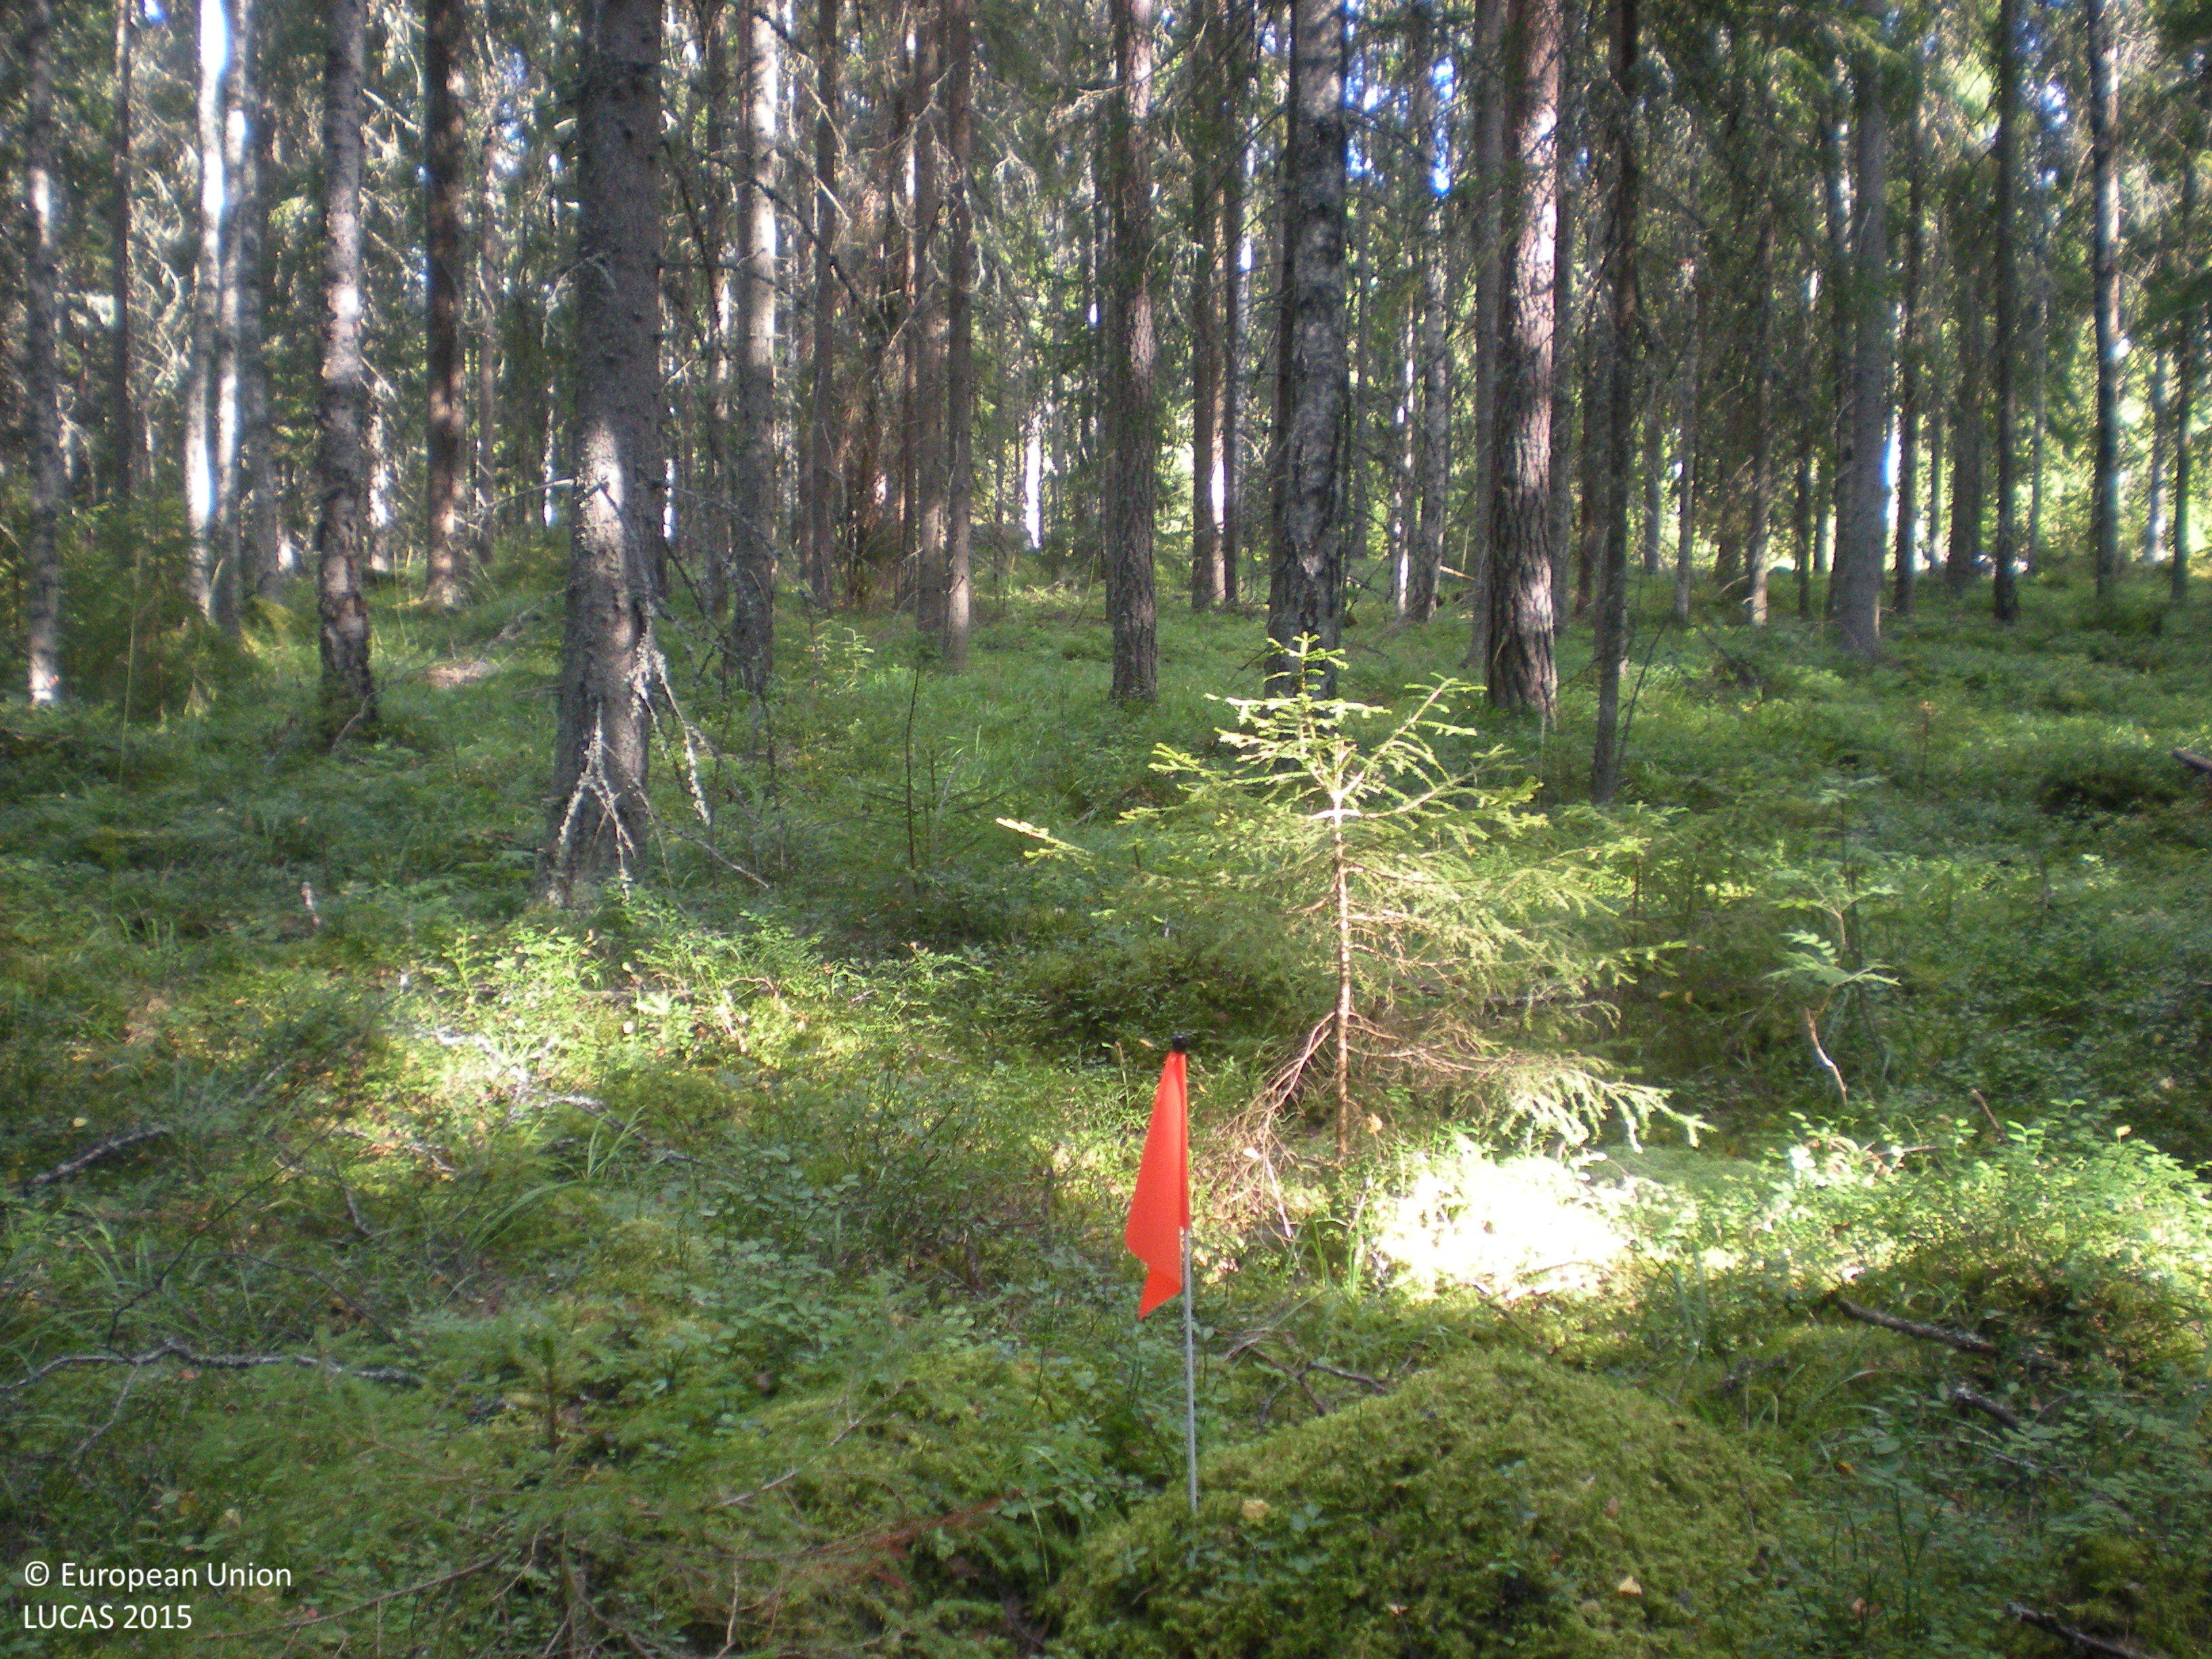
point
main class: Woodland
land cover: Spruce dominated coniferous woodland
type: boreal forest
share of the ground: 50 - 75 %
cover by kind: coniferous forest trees 60 %, broadleaved forest trees 15 %, shrubs 15 %, herbaceous plants 5 %, lichens and mosses 5 %
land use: Forestry
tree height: > 5 m
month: August
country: SE
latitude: 60.5125
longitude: 16.6363
